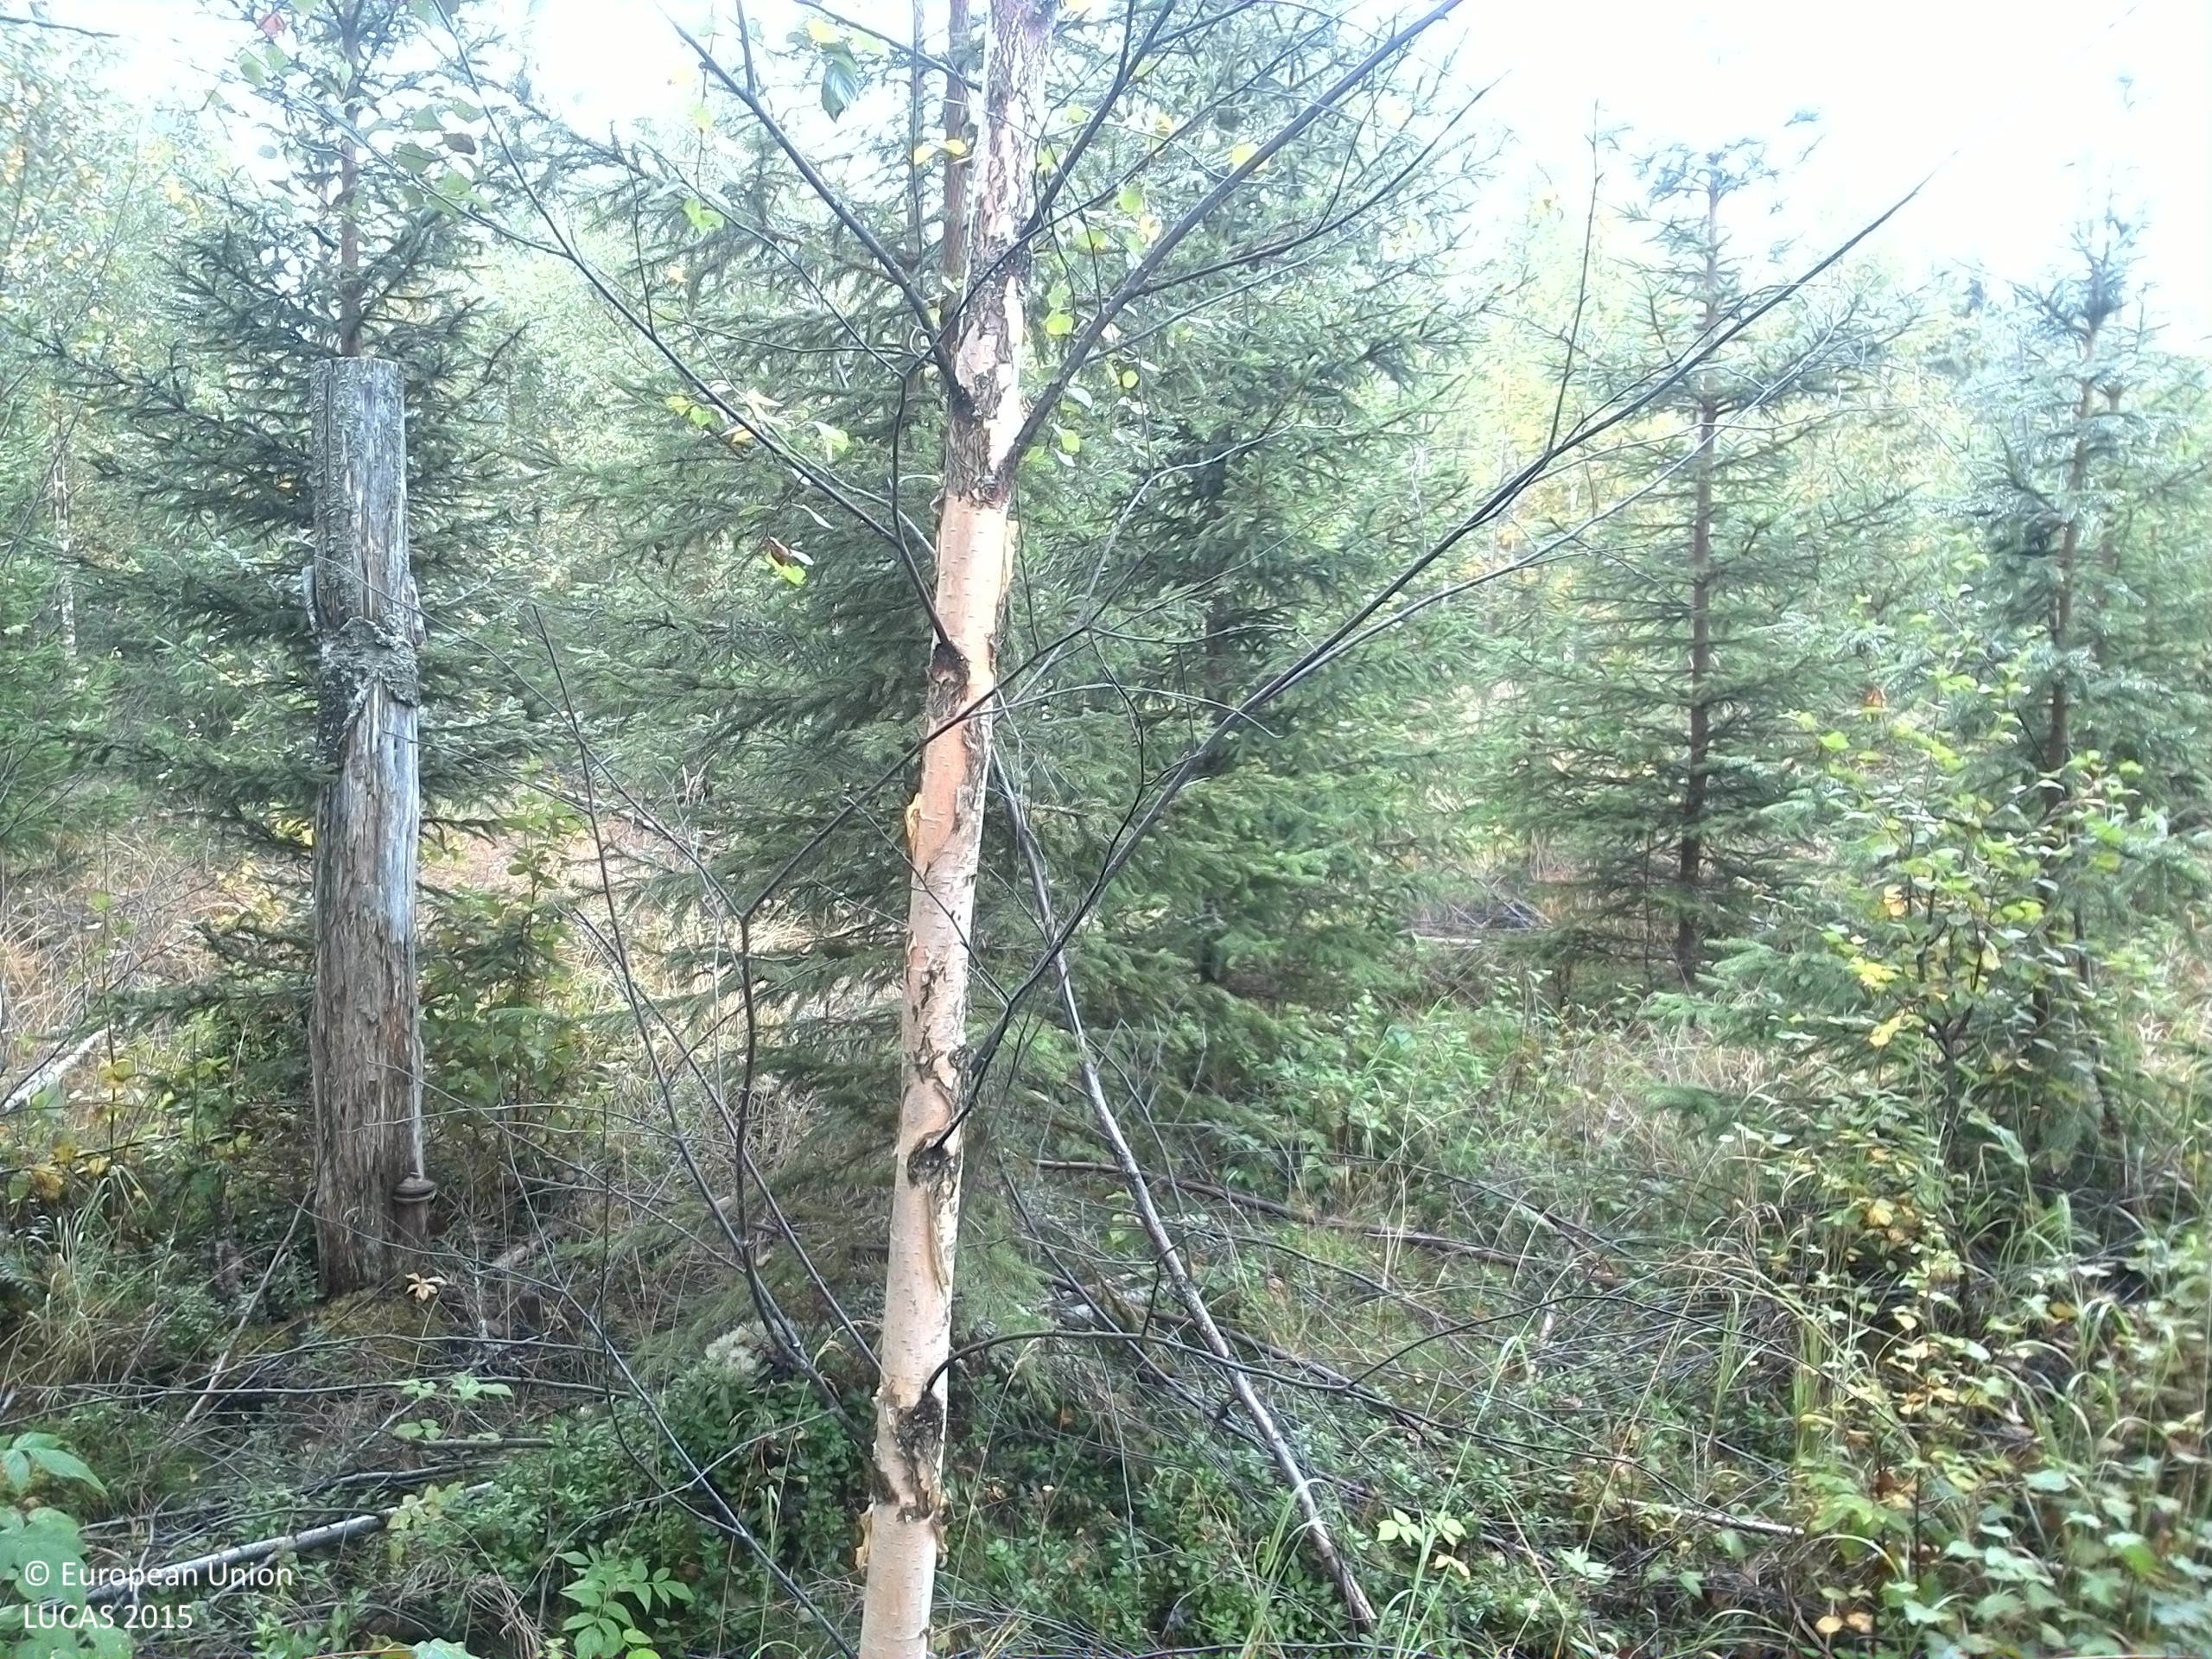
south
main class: Woodland
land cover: Spruce dominated mixed woodland
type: boreal forest
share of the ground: 50 - 75 %
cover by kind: coniferous forest trees 40 %, broadleaved forest trees 20 %, shrubs 20 %, herbaceous plants 10 %, lichens and mosses 10 %
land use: Forestry
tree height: < 5 m
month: September
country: SE
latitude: 61.6549
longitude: 15.2135
